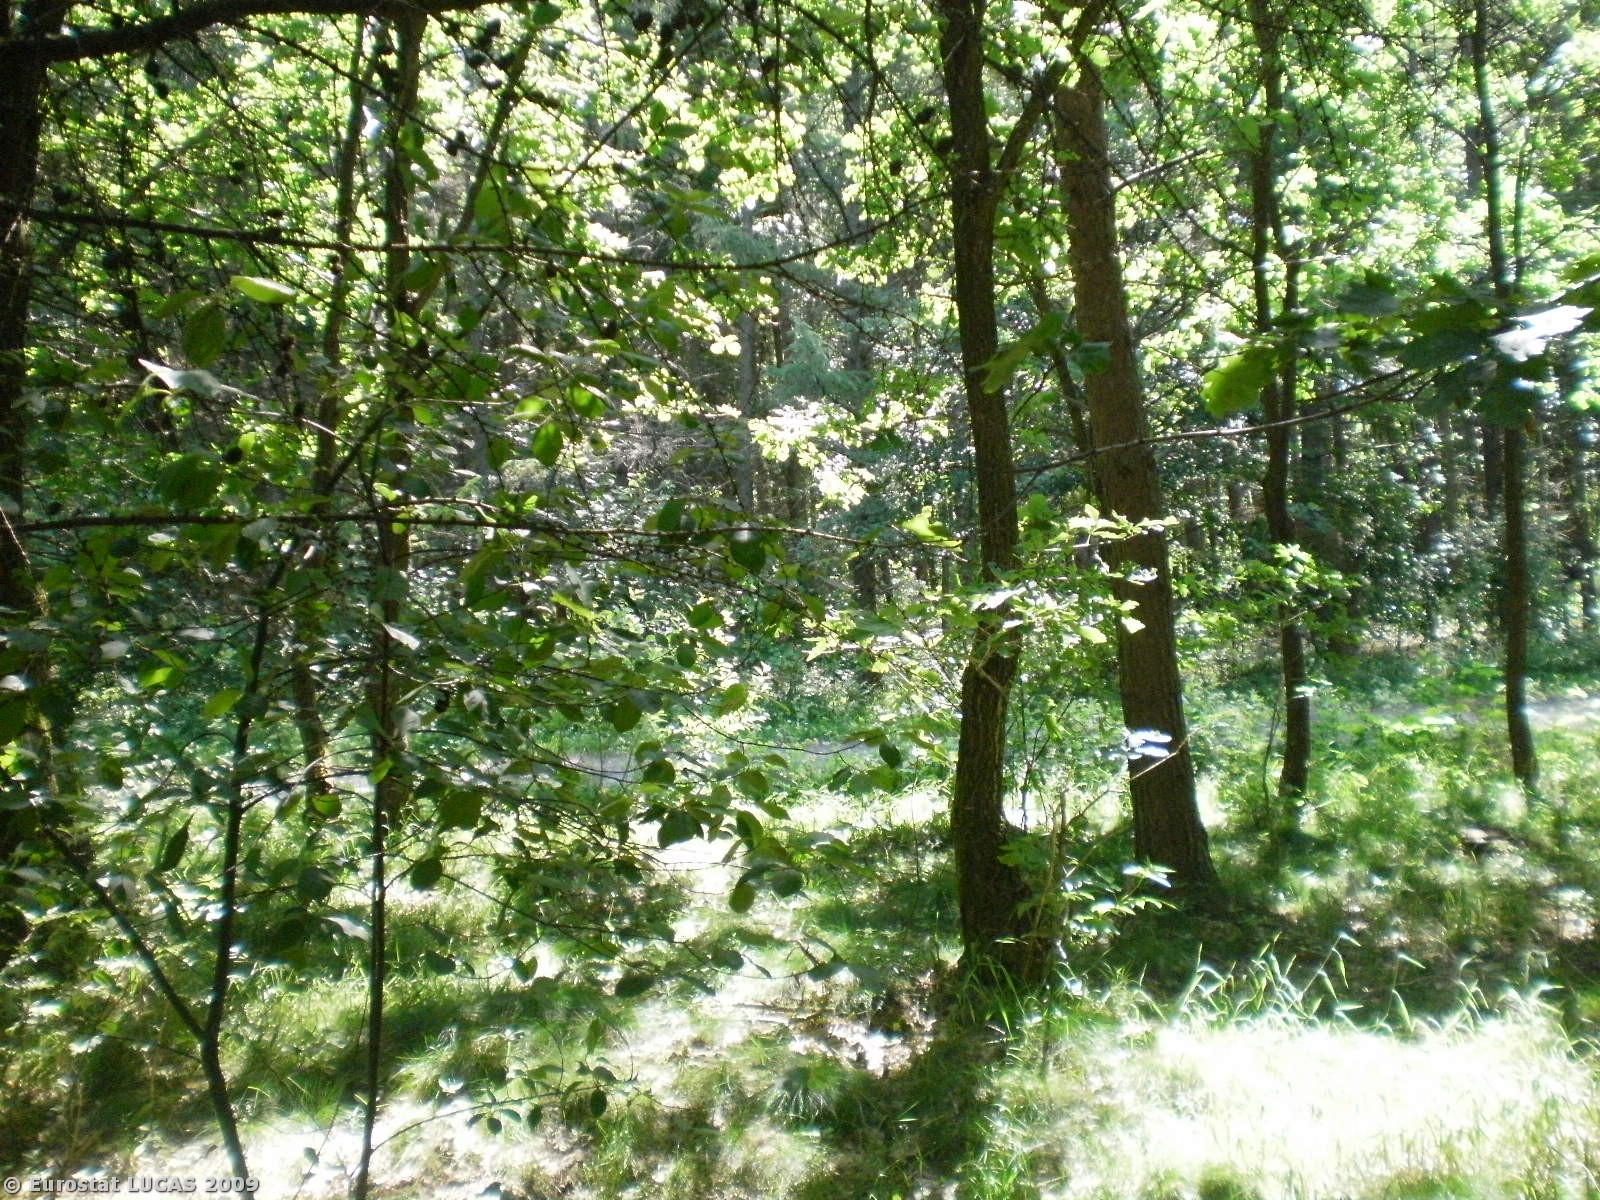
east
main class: Woodland
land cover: Mixed woodland
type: hemiboreal forest and nemoral coniferous forest and mixed broadleaved-coniferous forest
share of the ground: > 75 %
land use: Forestry
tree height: > 5 m
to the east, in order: Mixed woodland; Grass margins; Ditches and canals; Paved roads, cycling and walking lanes; Grass margins; Coniferous woodland; Tracks; Broadleaved woodland
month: June
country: PL
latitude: 54.4628
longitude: 17.3066
